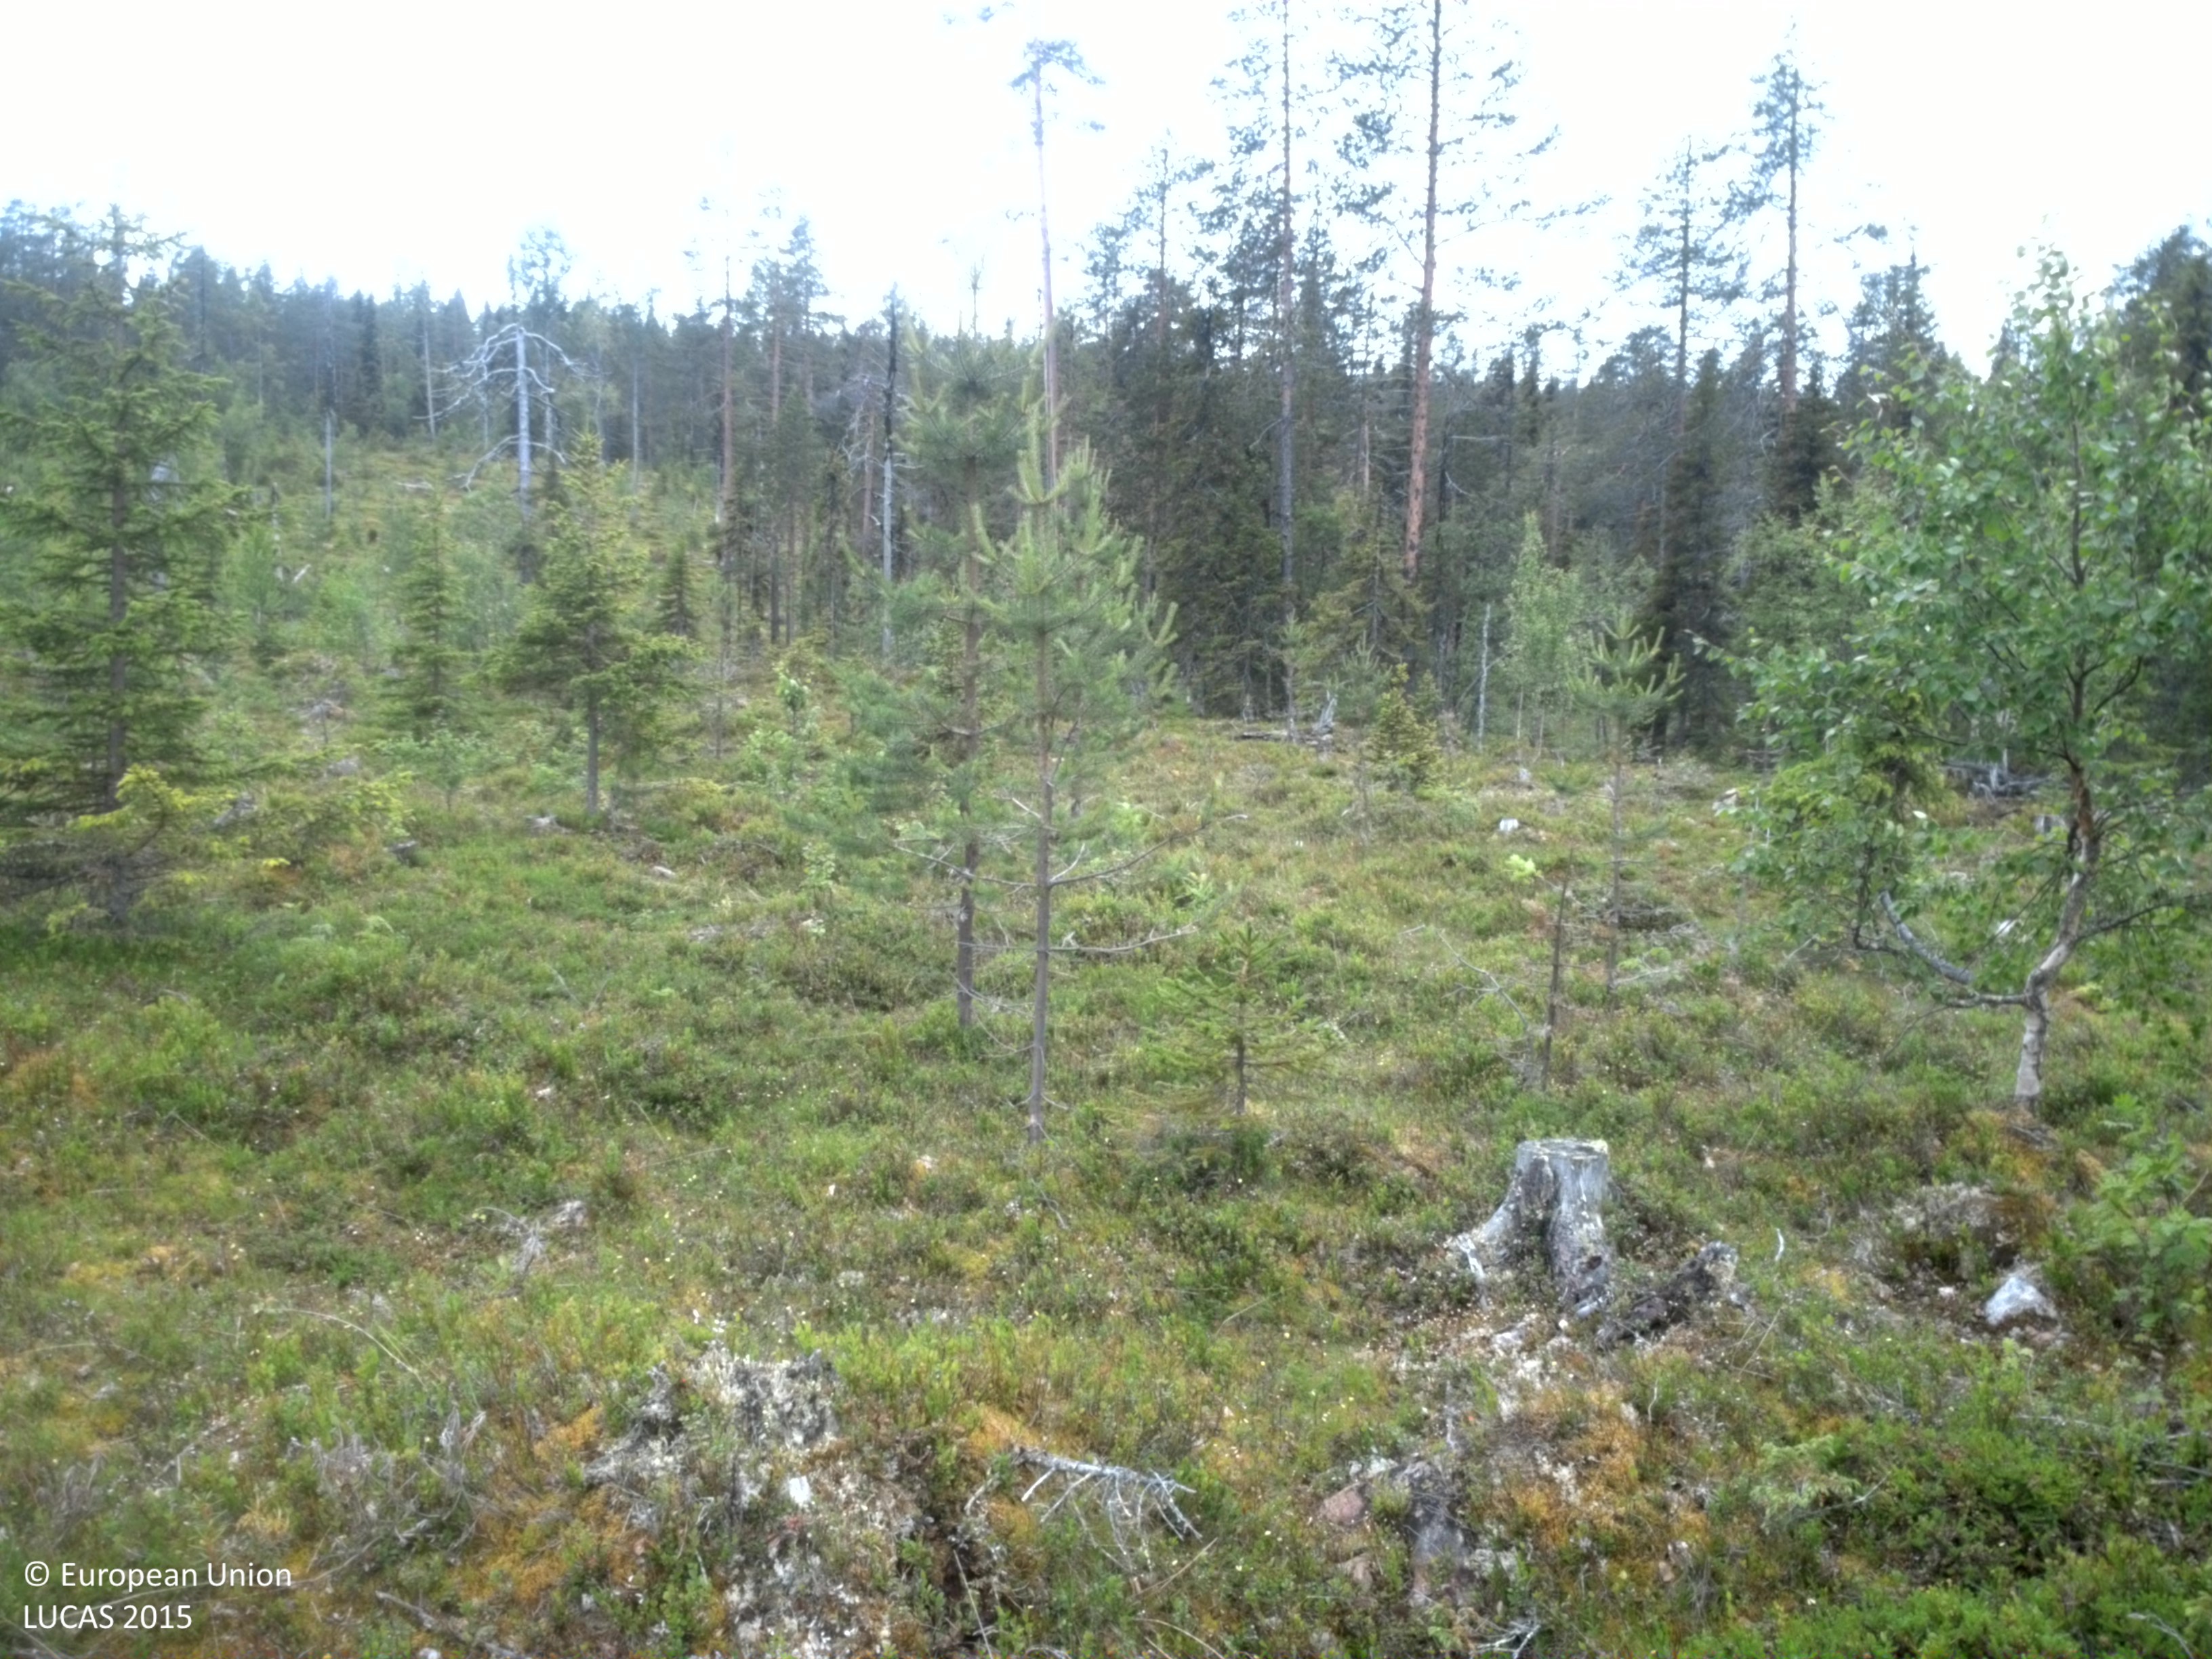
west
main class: Woodland
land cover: Pine dominated mixed woodland
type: boreal forest
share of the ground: 10 - 25 %
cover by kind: shrubs 80 %, coniferous forest trees 10 %, broadleaved forest trees 5 %, consolidated bare surface 5 %
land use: Forestry
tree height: < 5 m
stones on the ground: > 50 %
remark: Clear cut
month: August
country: SE
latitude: 66.1518
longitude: 19.8650
